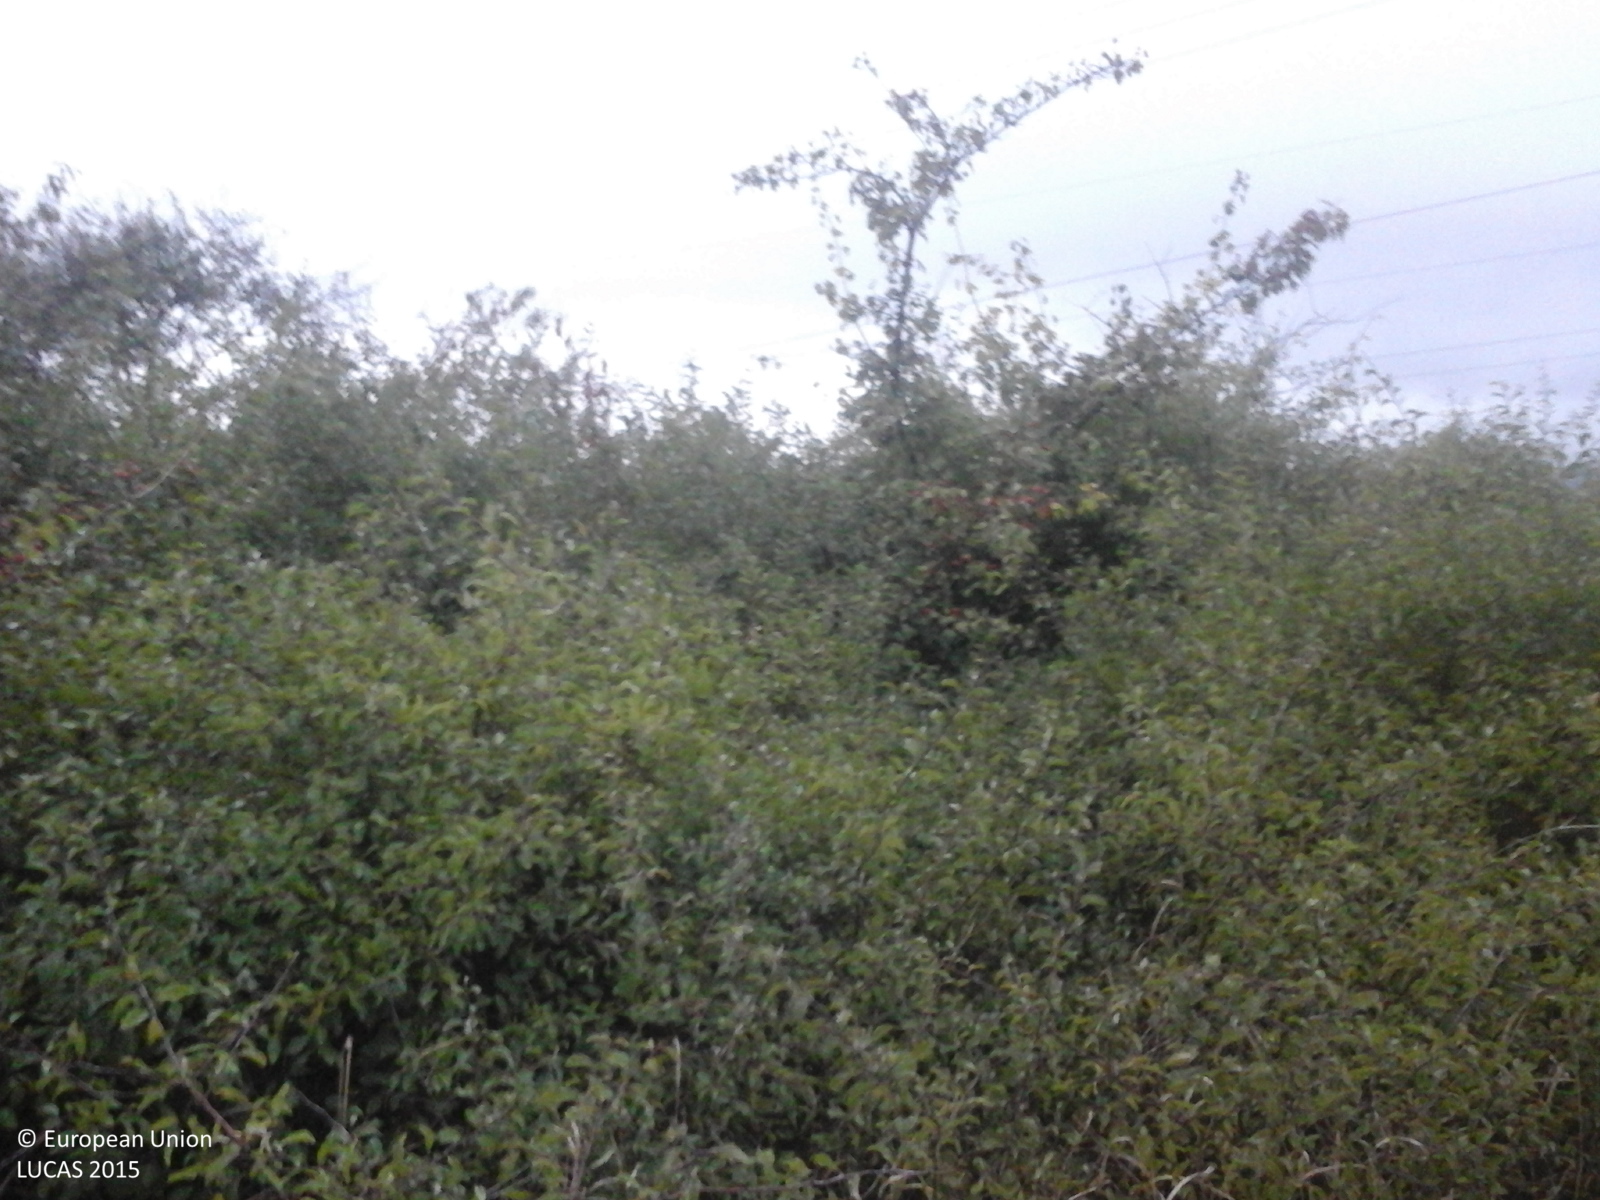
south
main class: Grassland
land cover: Grassland with sparse tree/shrub cover
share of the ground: > 75 %
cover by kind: herbaceous plants 85 %, shrubs 10 %, broadleaved forest trees 5 %
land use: Fallow land
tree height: < 5 m
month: September
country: RO
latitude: 45.8520
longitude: 23.8099
